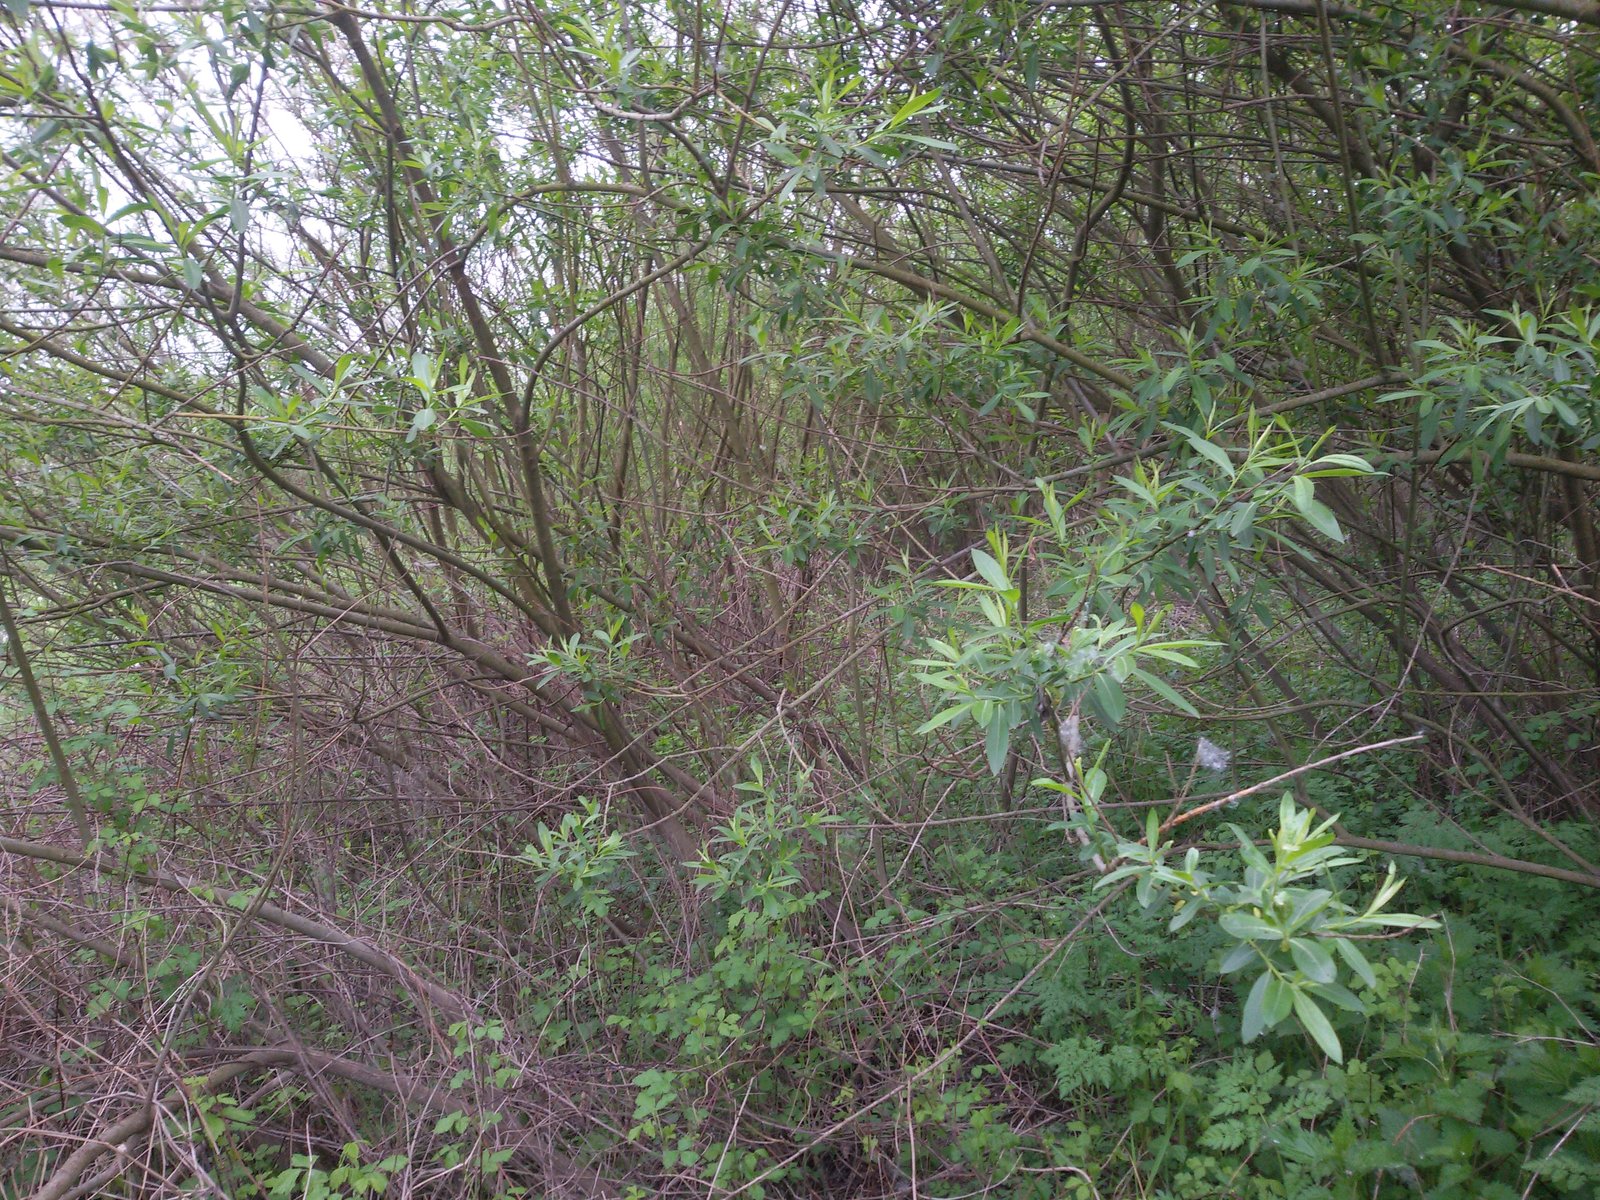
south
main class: Shrubland
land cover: Shrubland without tree cover
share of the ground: 25 - 50 %
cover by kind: herbaceous plants 70 %, shrubs 30 %
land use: Semi-natural and natural areas not in use
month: May
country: PL
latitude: 50.4296
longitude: 21.3813
